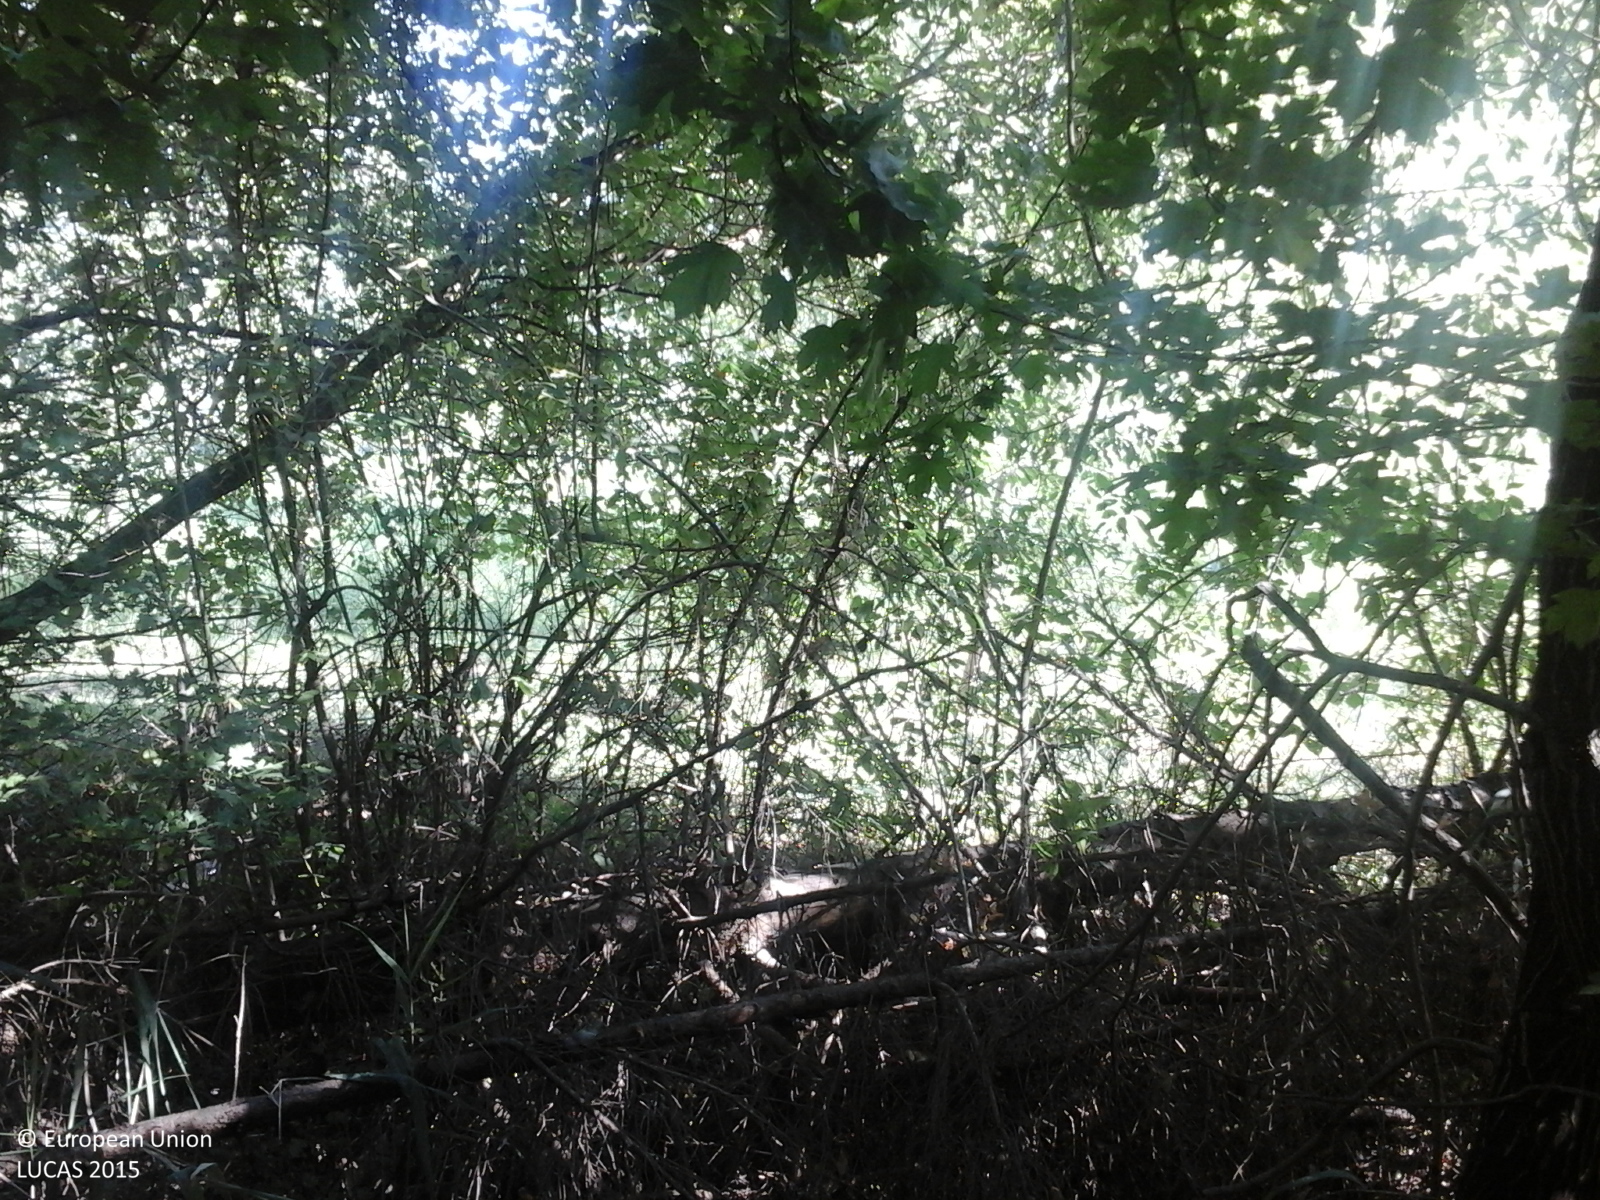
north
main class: Woodland
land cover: Spruce dominated coniferous woodland
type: alpine coniferous forest
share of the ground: > 75 %
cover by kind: coniferous forest trees 75 %, broadleaved forest trees 25 %
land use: Forestry
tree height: > 5 m
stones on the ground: 10 - 25 %
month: July
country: RO
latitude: 46.6110
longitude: 27.2476
